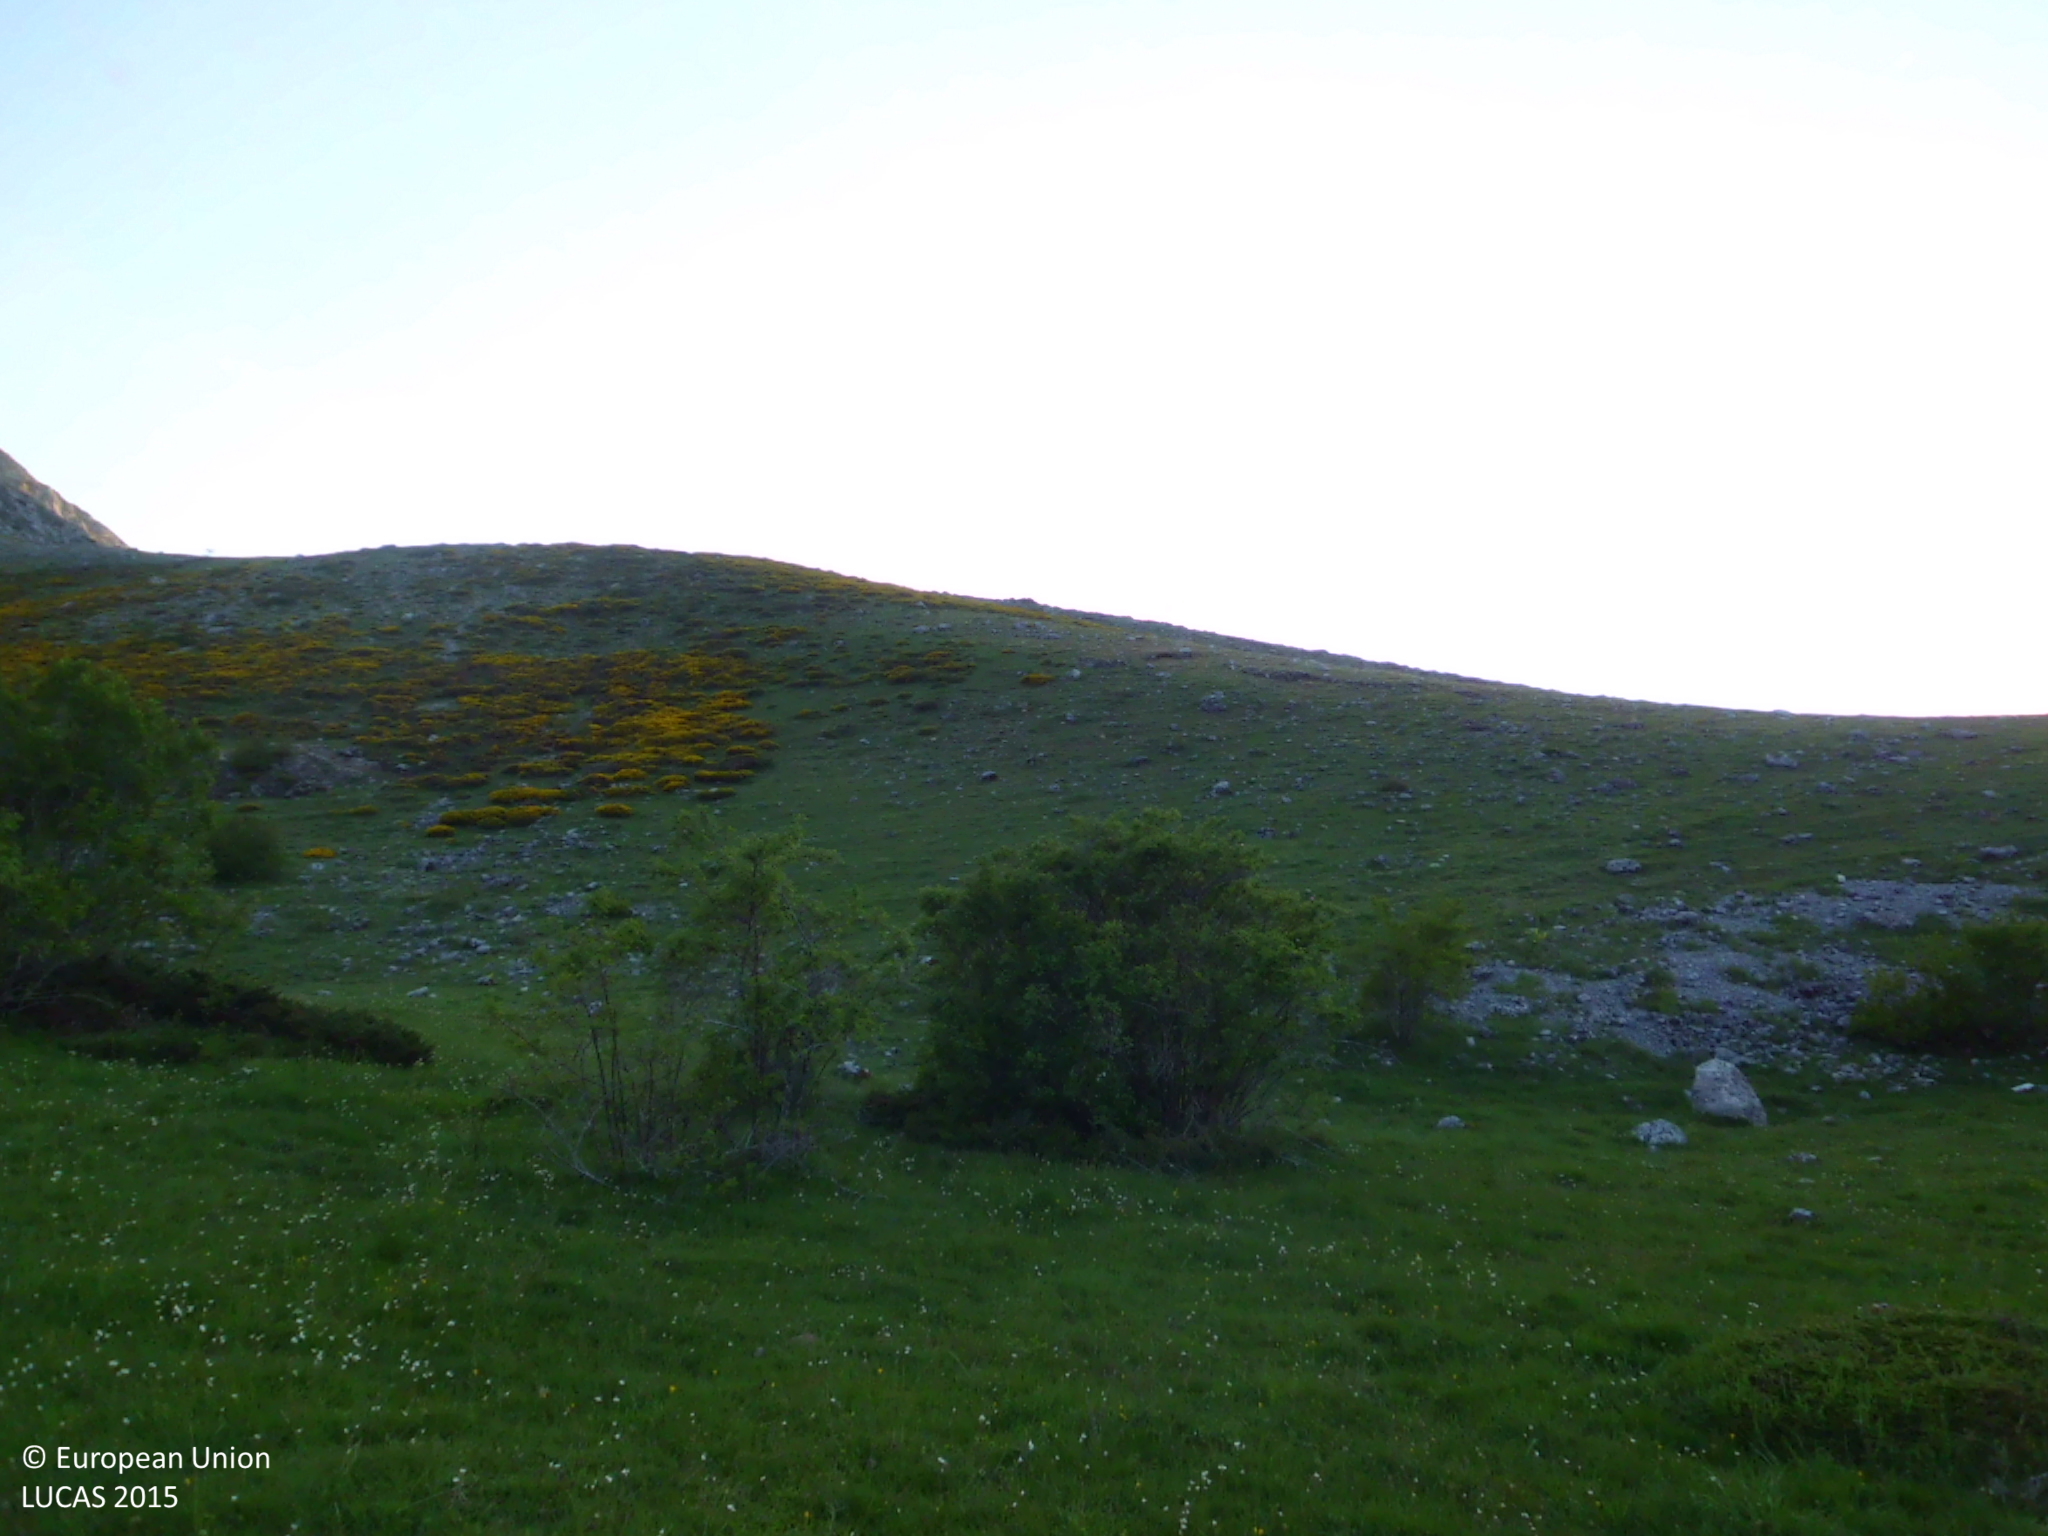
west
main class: Grassland
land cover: Grassland without tree/shrub cover
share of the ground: > 75 %
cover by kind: herbaceous plants 100 %
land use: Agriculture (excluding fallow land and kitchen gardens)
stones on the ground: < 10 %
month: May
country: ES
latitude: 43.0426
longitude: -5.1807
